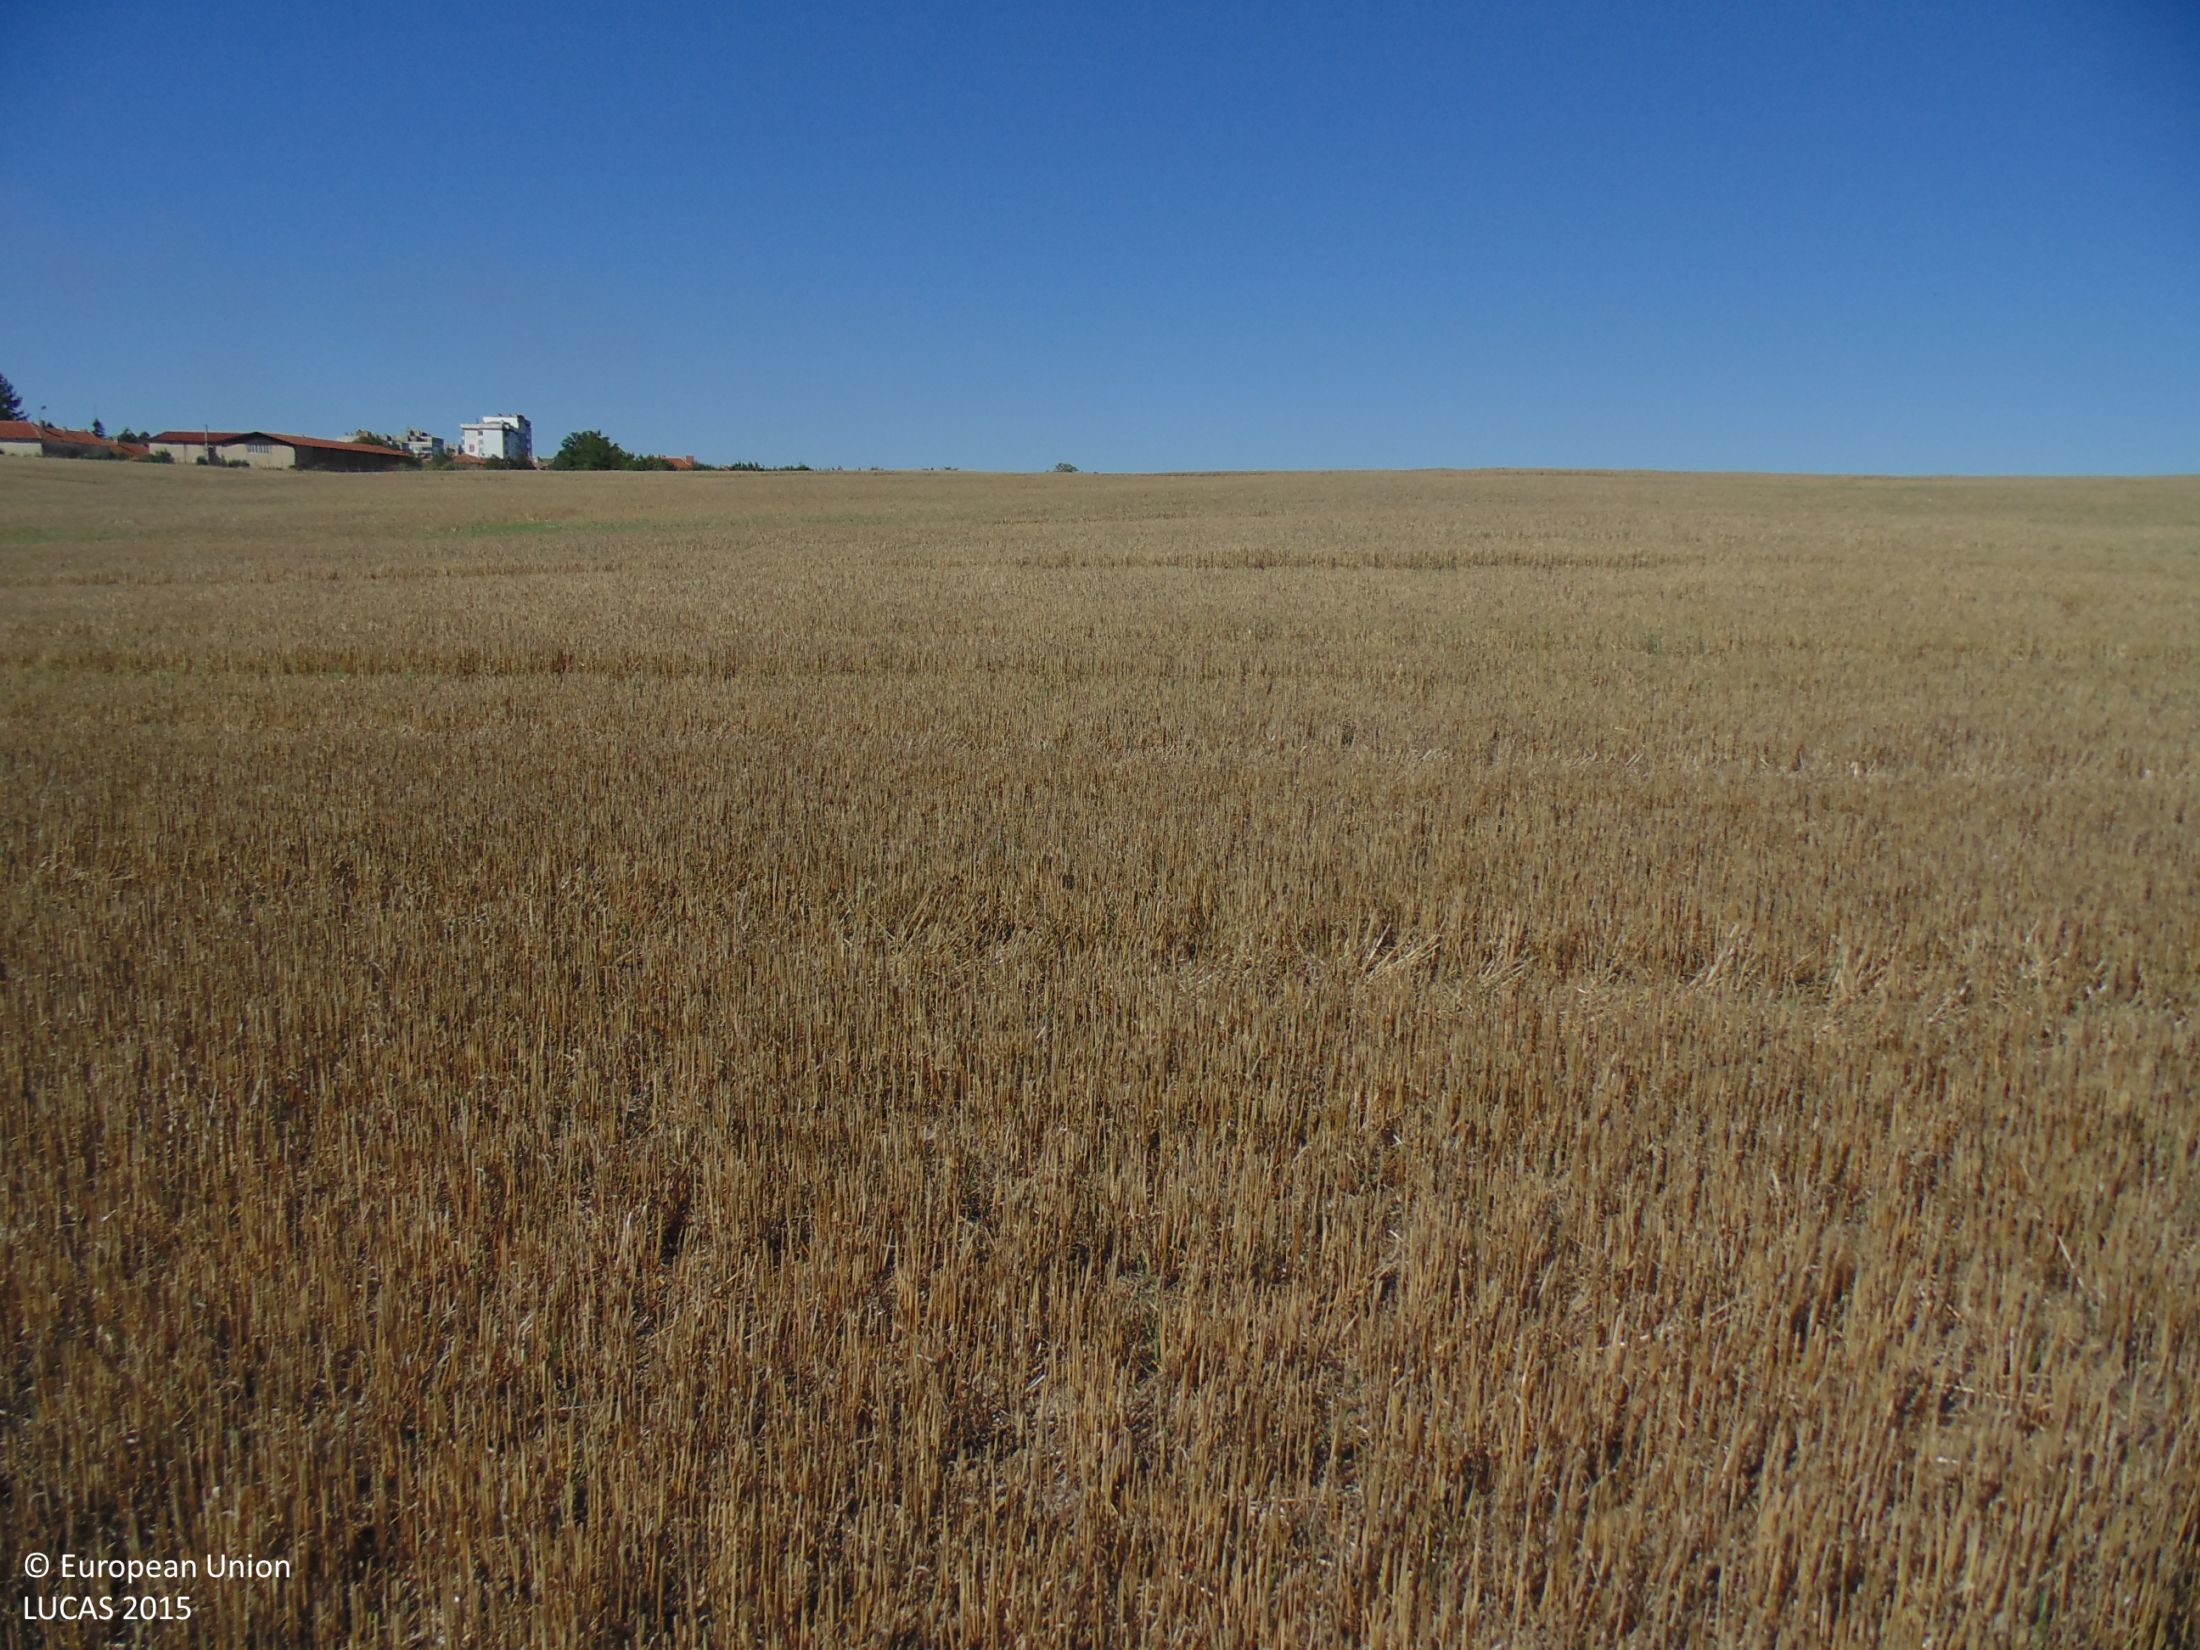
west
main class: Cropland
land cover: Common wheat
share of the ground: > 75 %
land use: Agriculture (excluding fallow land and kitchen gardens)
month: September
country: BG
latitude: 43.8302
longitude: 27.1495
